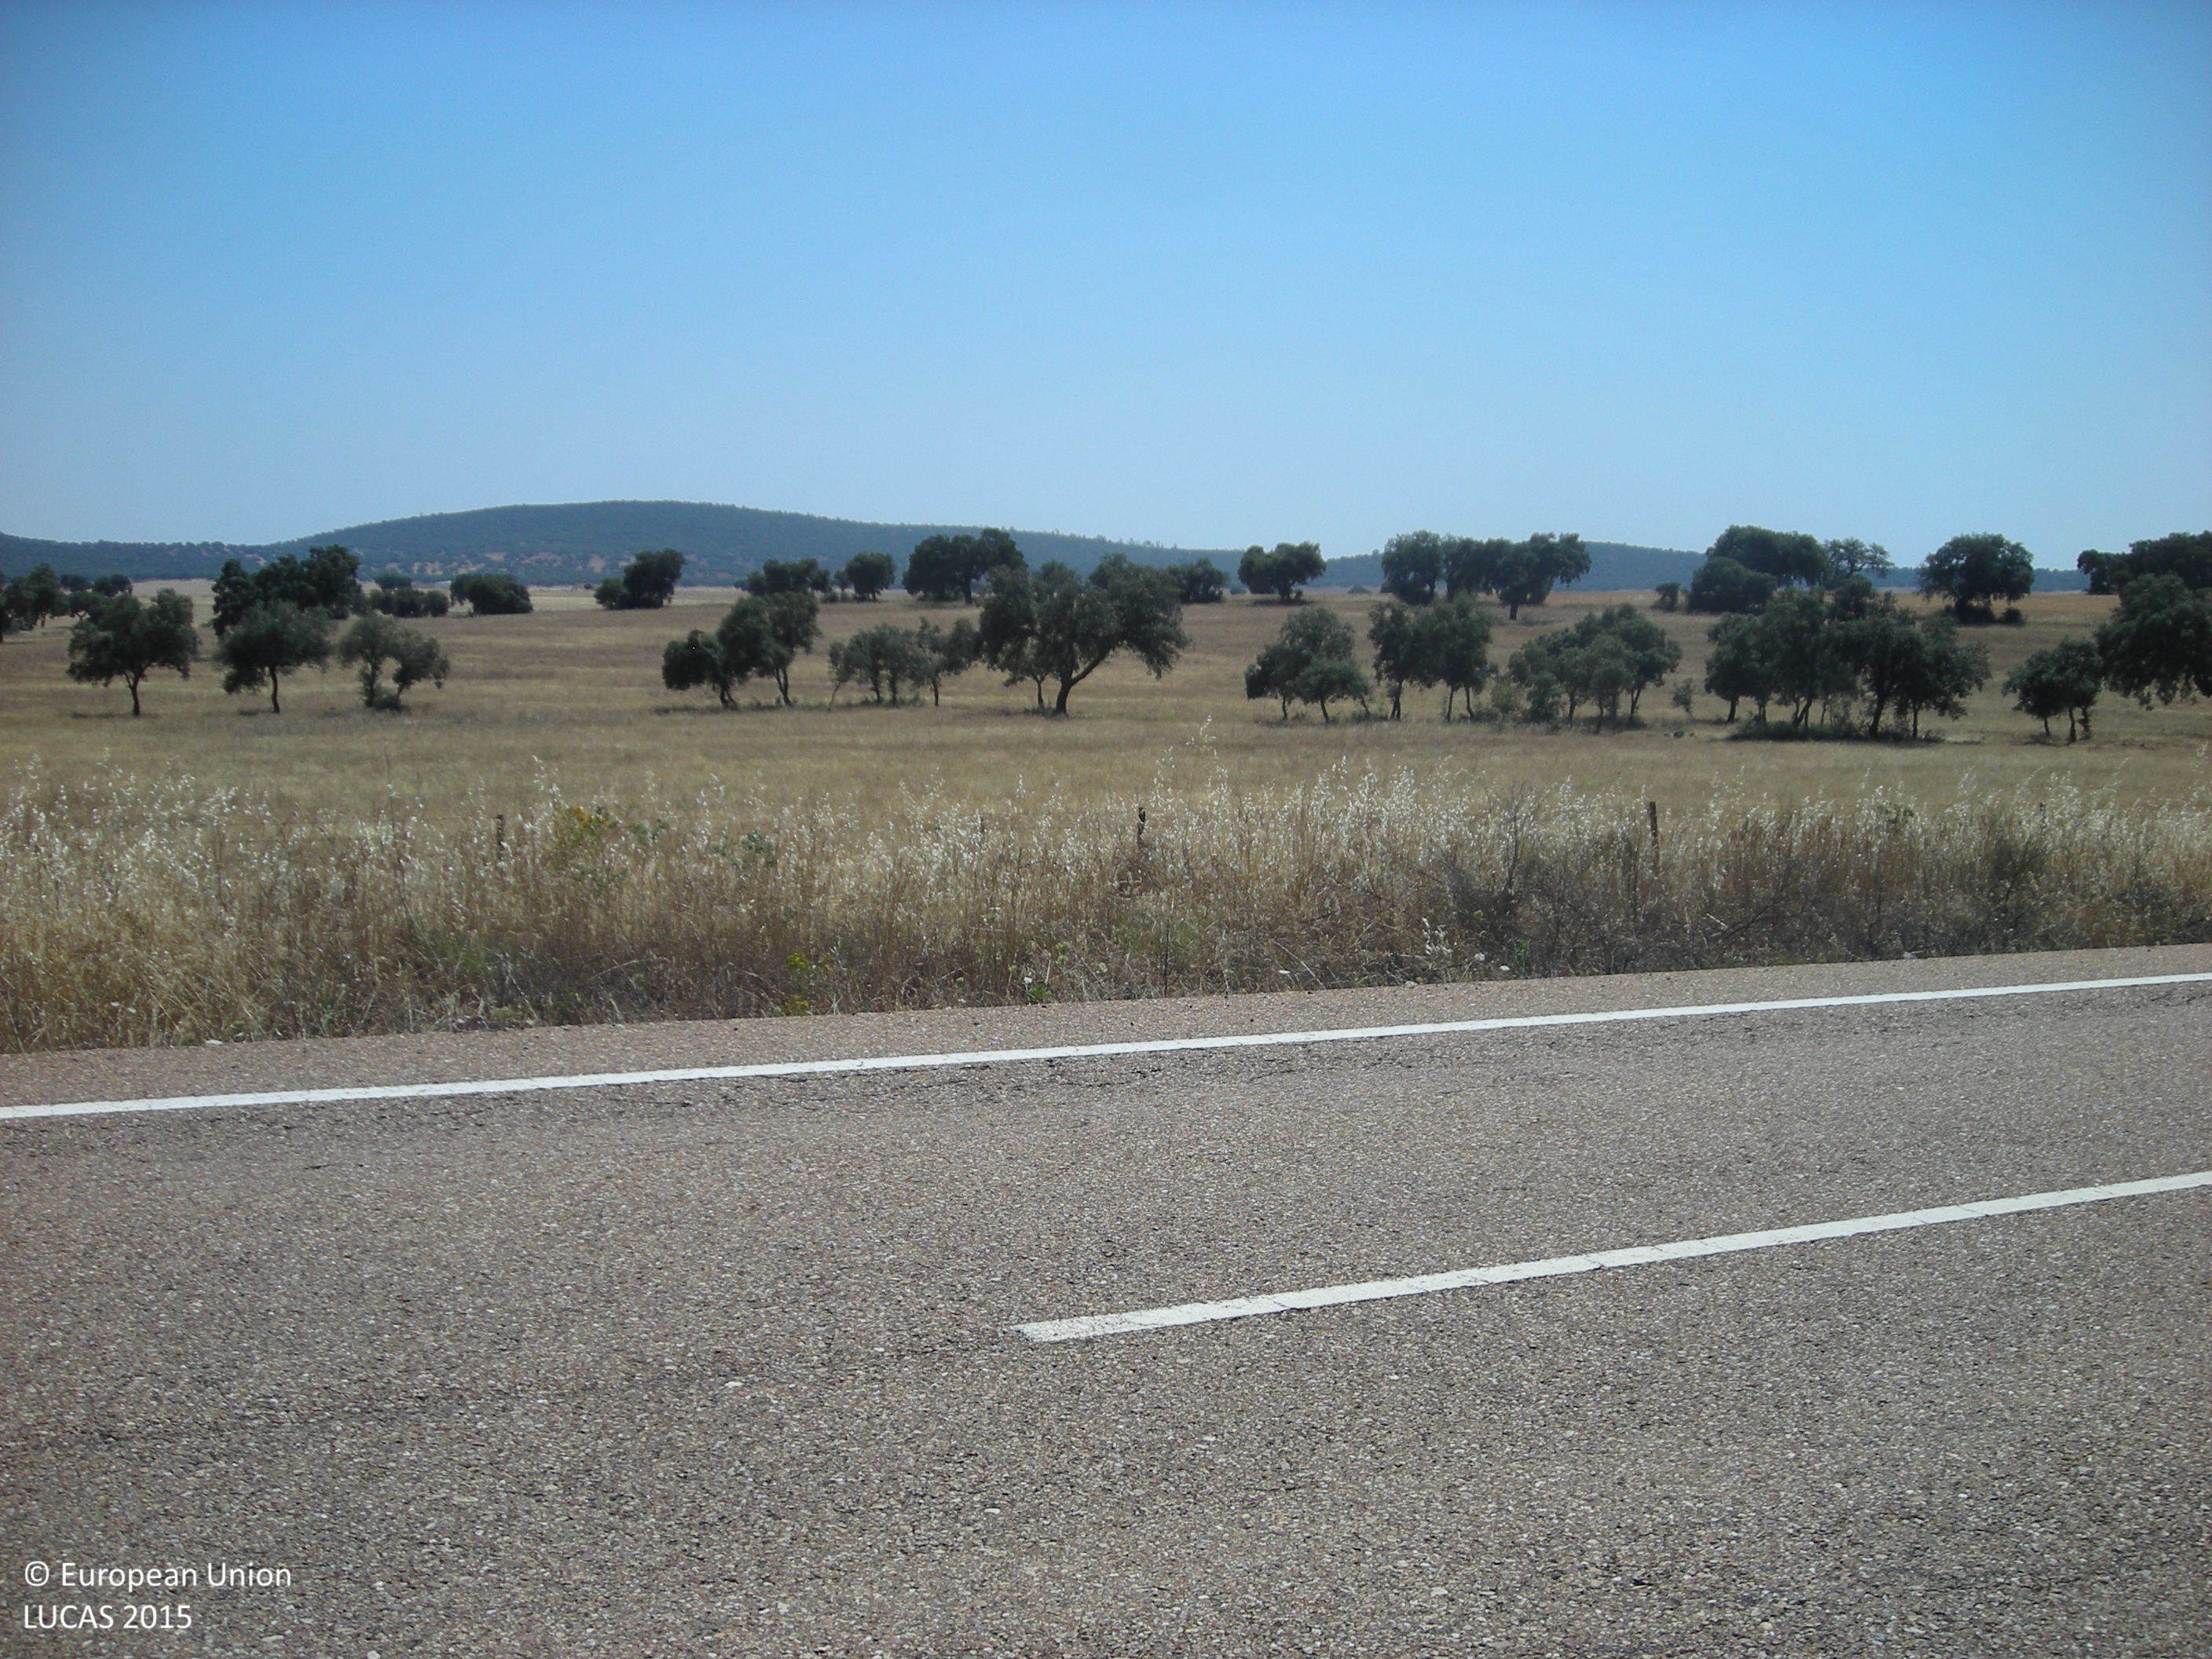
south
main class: Shrubland
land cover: Shrubland without tree cover
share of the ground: > 75 %
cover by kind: shrubs 100 %
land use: Semi-natural and natural areas not in use
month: June
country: ES
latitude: 38.6501
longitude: -5.8897
